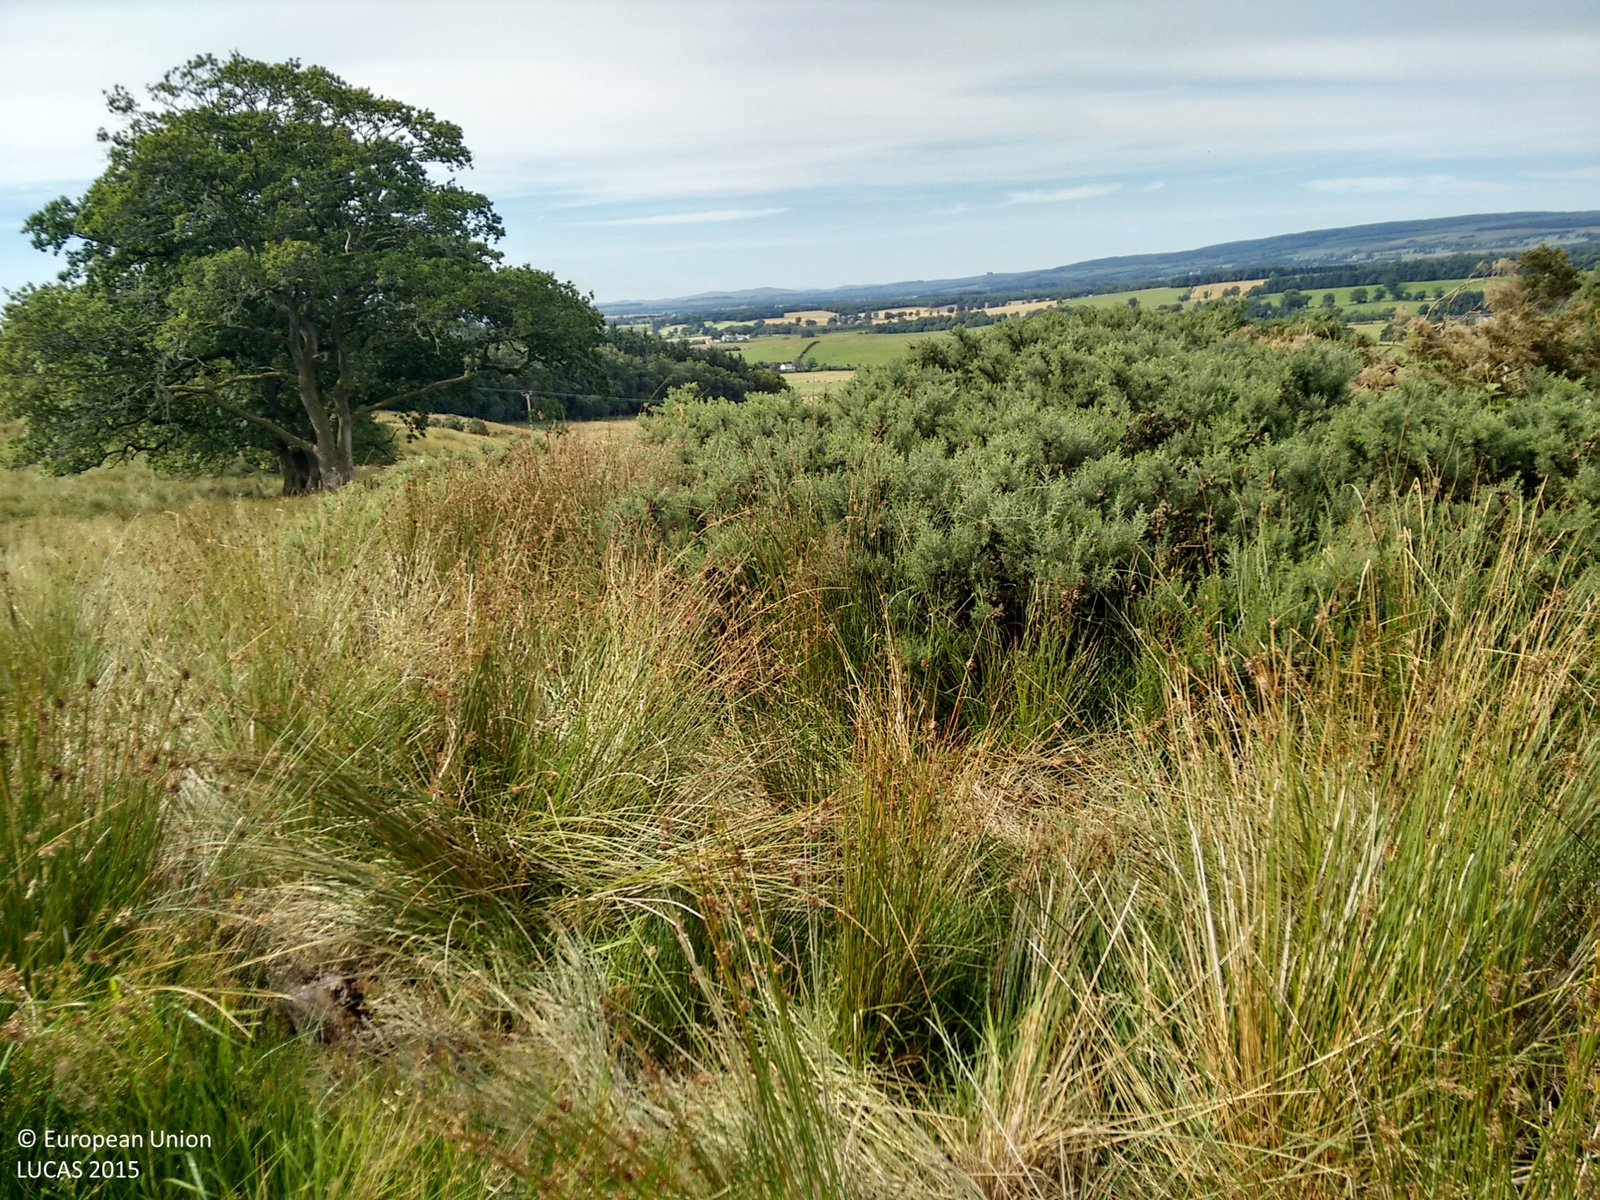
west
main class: Grassland
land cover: Grassland without tree/shrub cover
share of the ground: > 75 %
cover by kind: herbaceous plants 100 %
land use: Agriculture (excluding fallow land and kitchen gardens)
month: August
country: GB
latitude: 55.2082
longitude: -3.3880
